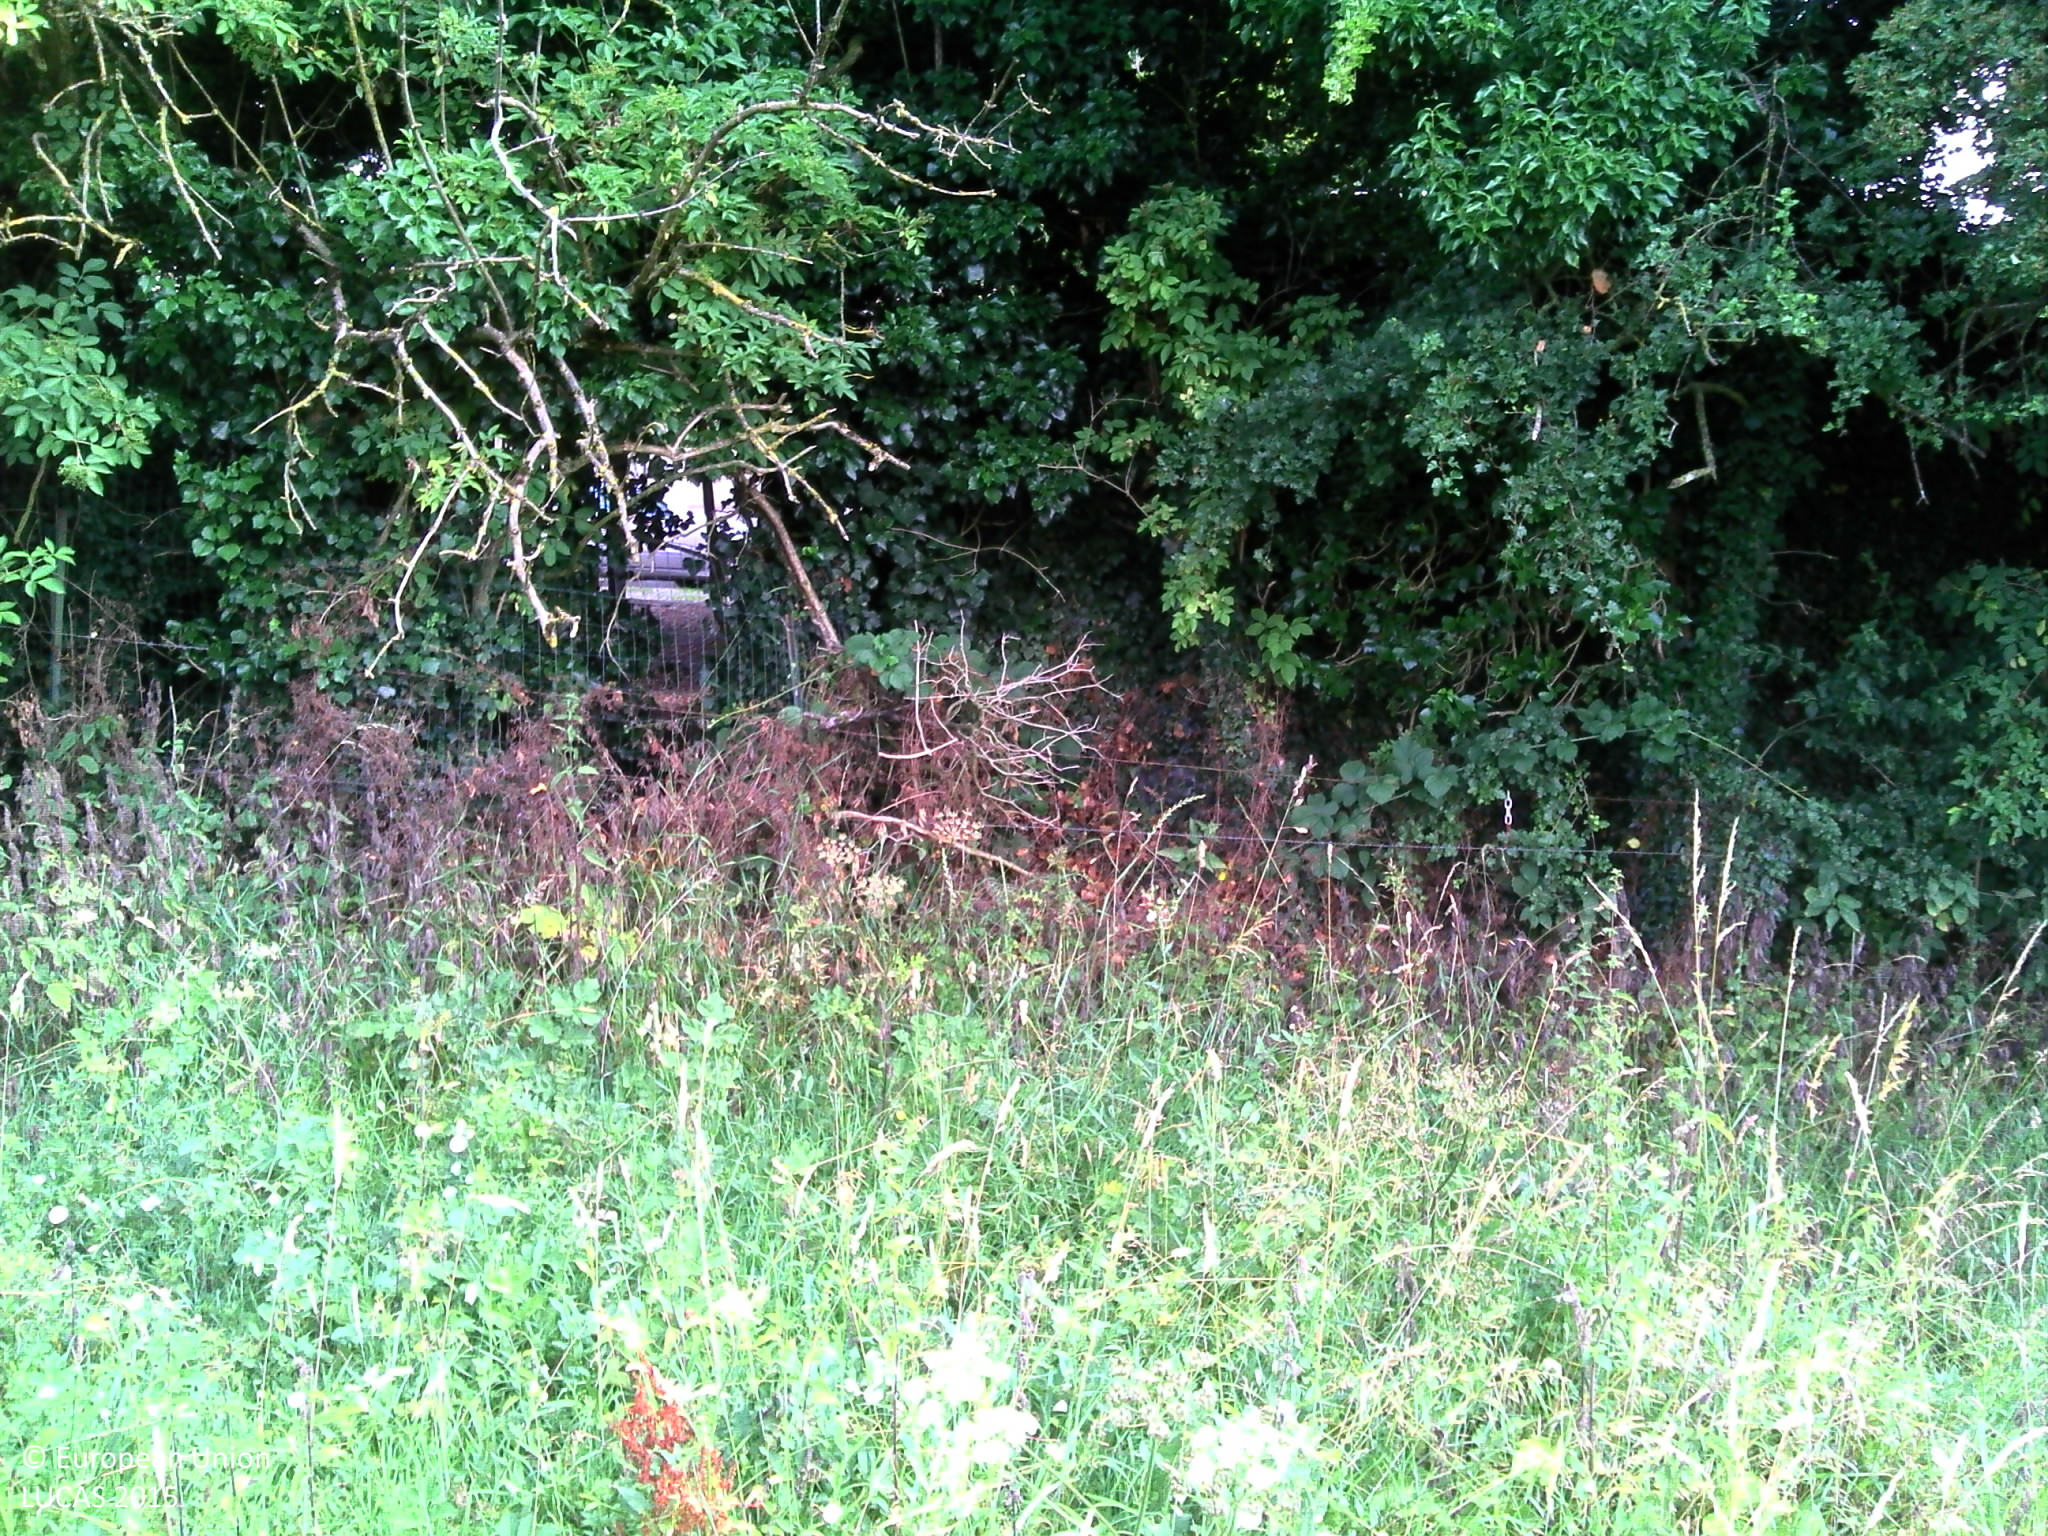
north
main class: Grassland
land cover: Grassland without tree/shrub cover
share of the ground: > 75 %
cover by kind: herbaceous plants 100 %
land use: Agriculture (excluding fallow land and kitchen gardens)
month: July
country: BE
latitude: 50.1787
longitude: 4.5207
